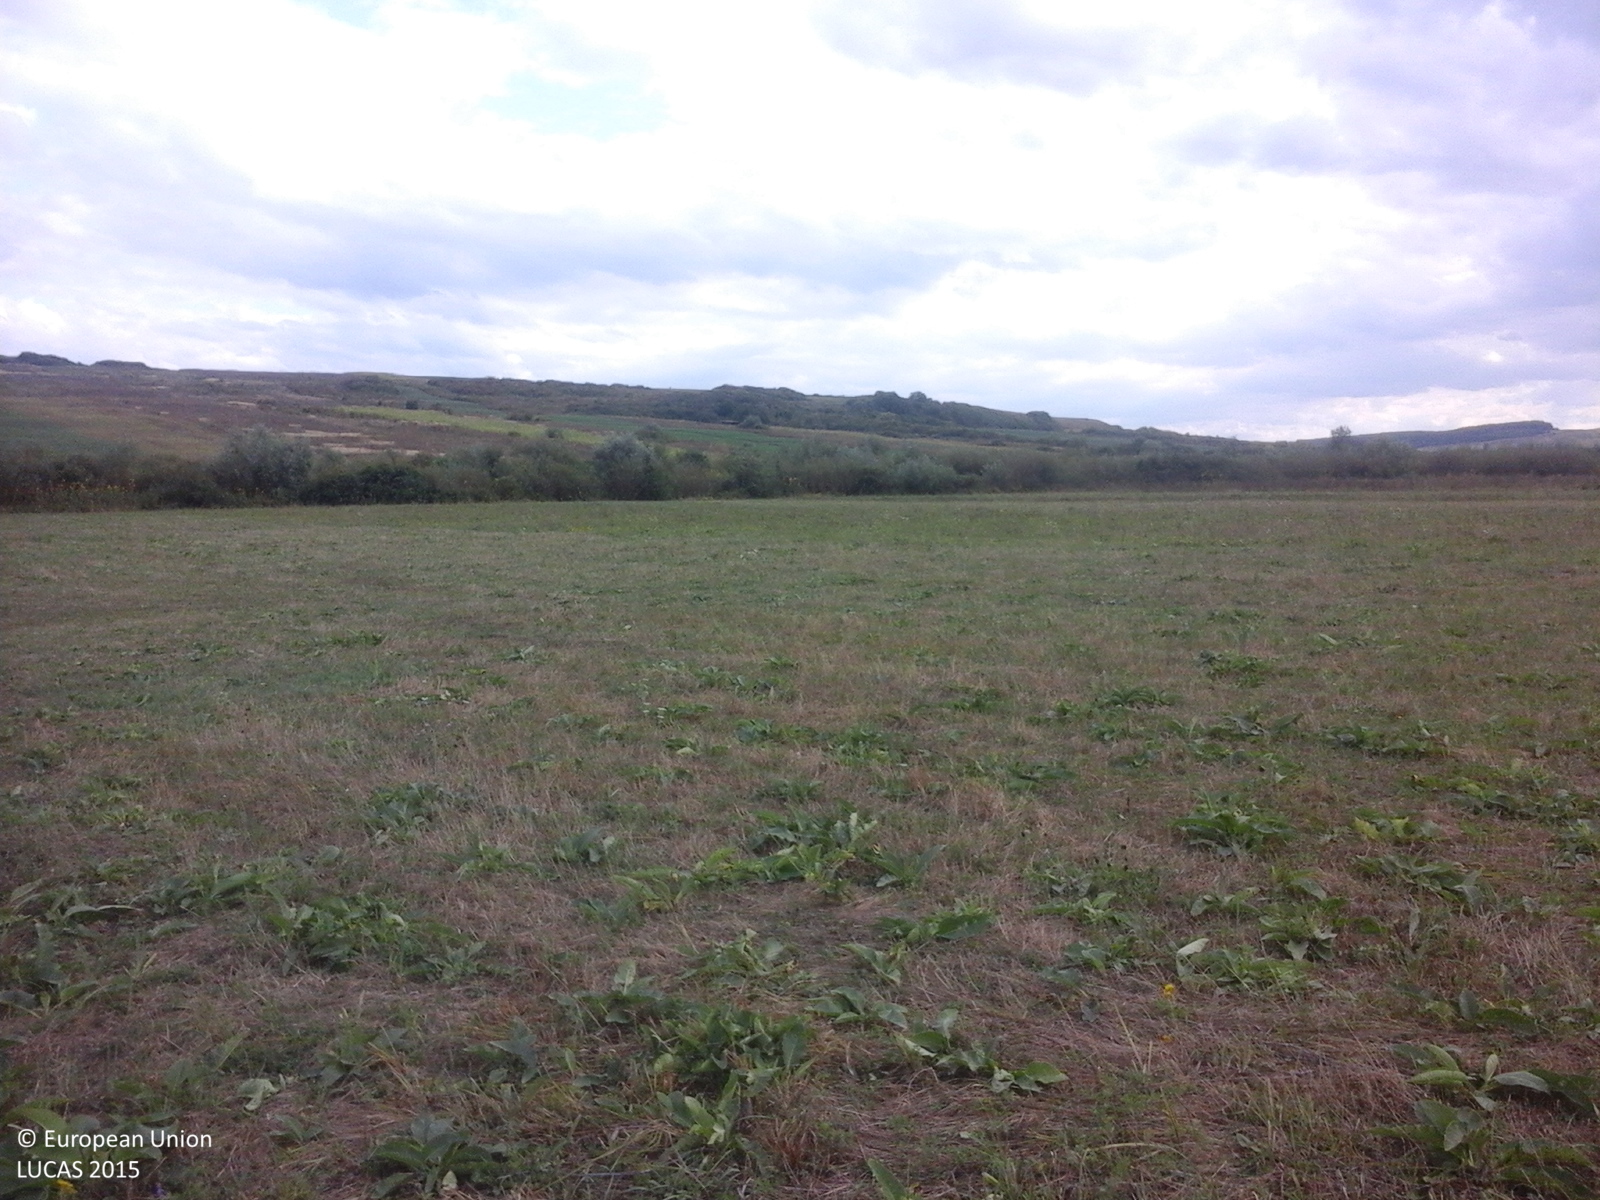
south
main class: Grassland
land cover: Grassland without tree/shrub cover
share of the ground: > 75 %
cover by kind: herbaceous plants 100 %
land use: Agriculture (excluding fallow land and kitchen gardens)
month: September
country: RO
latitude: 47.4635
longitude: 23.1882
